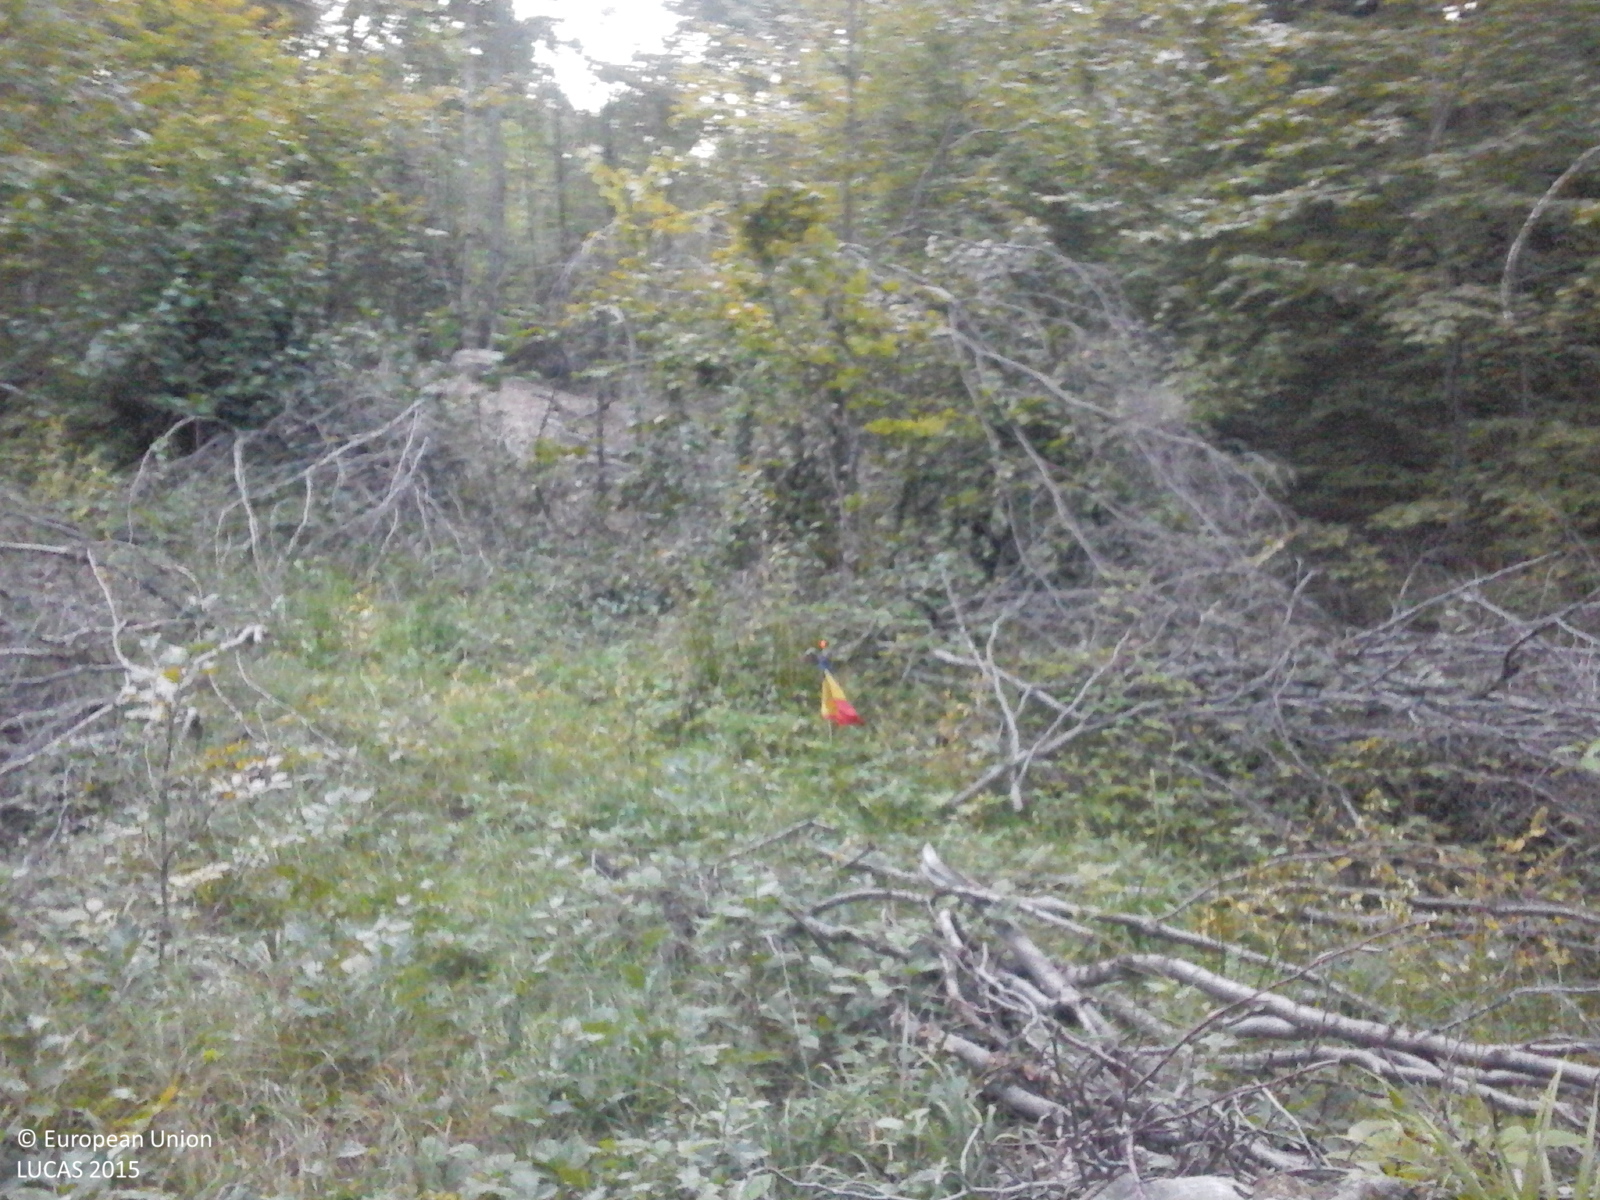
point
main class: Woodland
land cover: Broadleaved woodland
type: beech forest
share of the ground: > 75 %
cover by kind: broadleaved forest trees 100 %
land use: Forestry
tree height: > 5 m
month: September
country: RO
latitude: 46.7115
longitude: 23.3701
